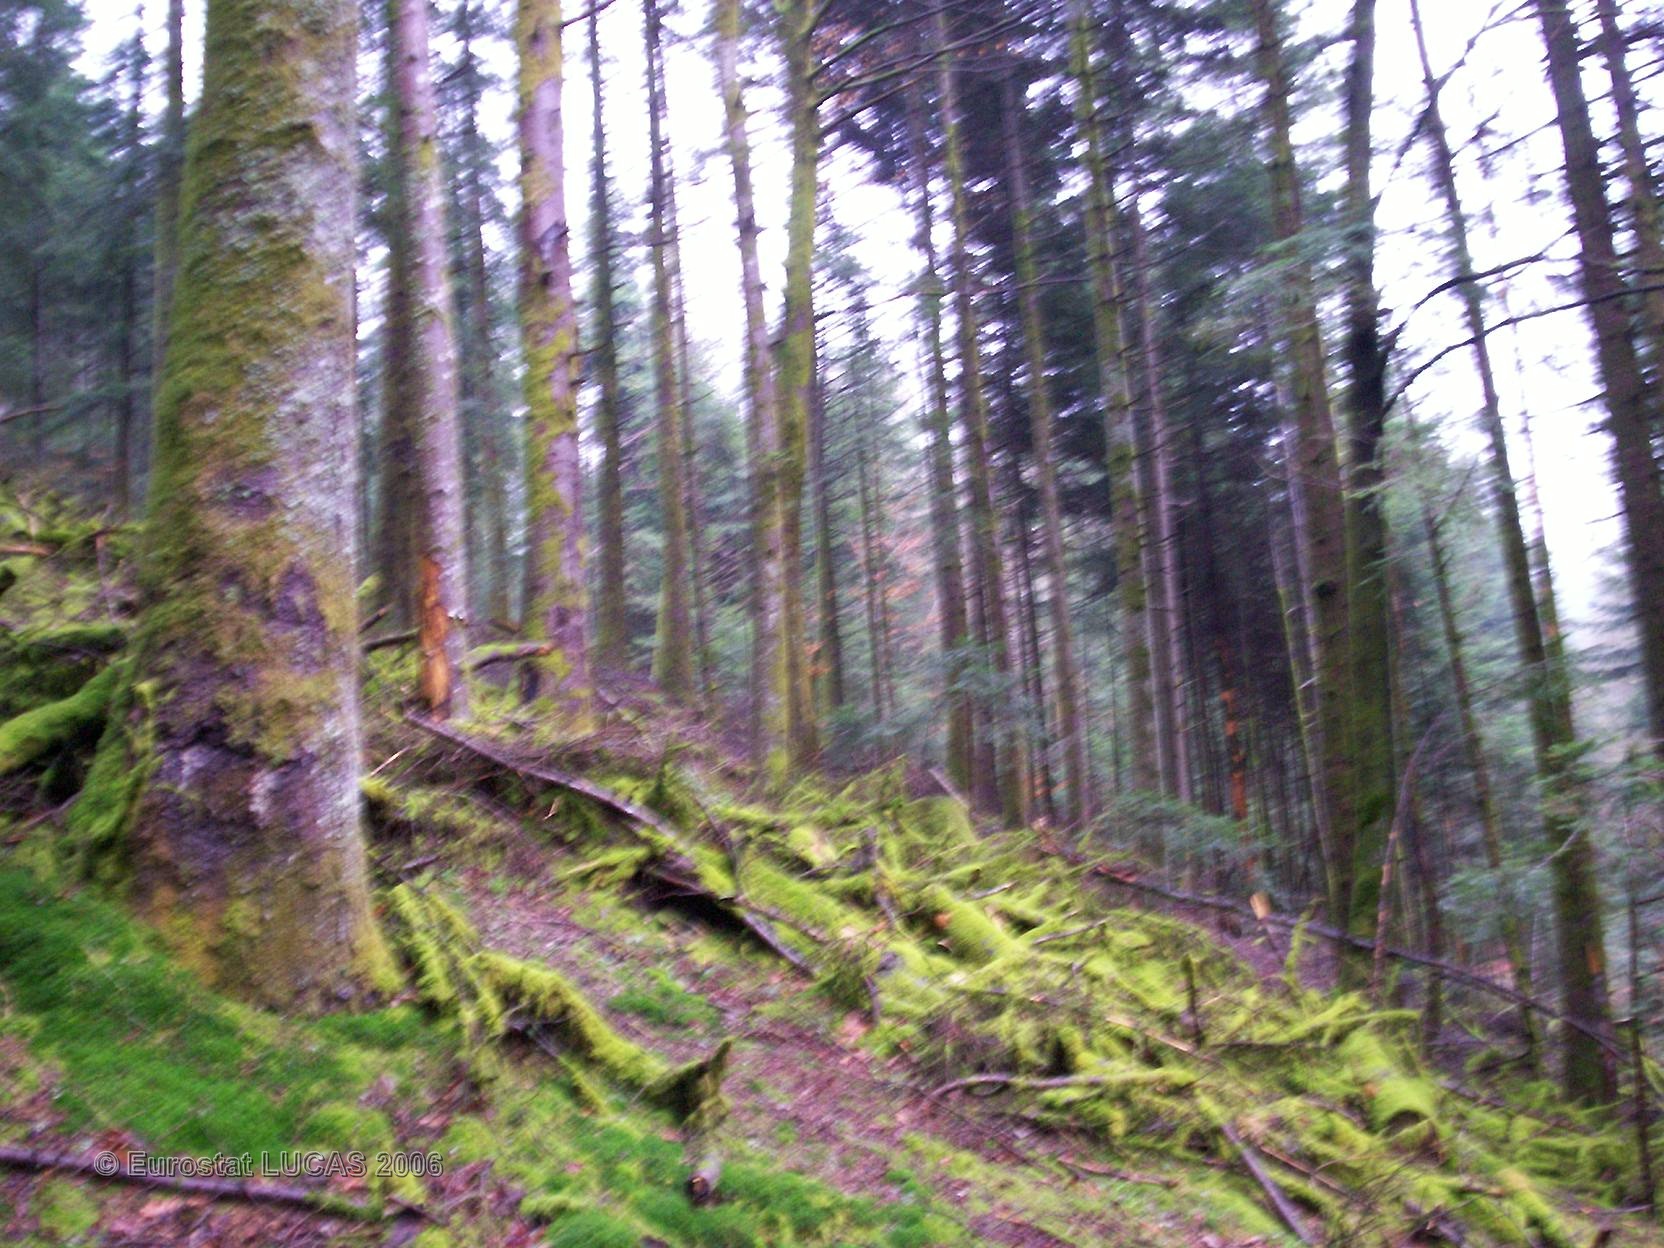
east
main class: Woodland
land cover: Coniferous forest
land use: Forestry
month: April
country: FR
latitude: 47.9897
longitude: 6.5572
